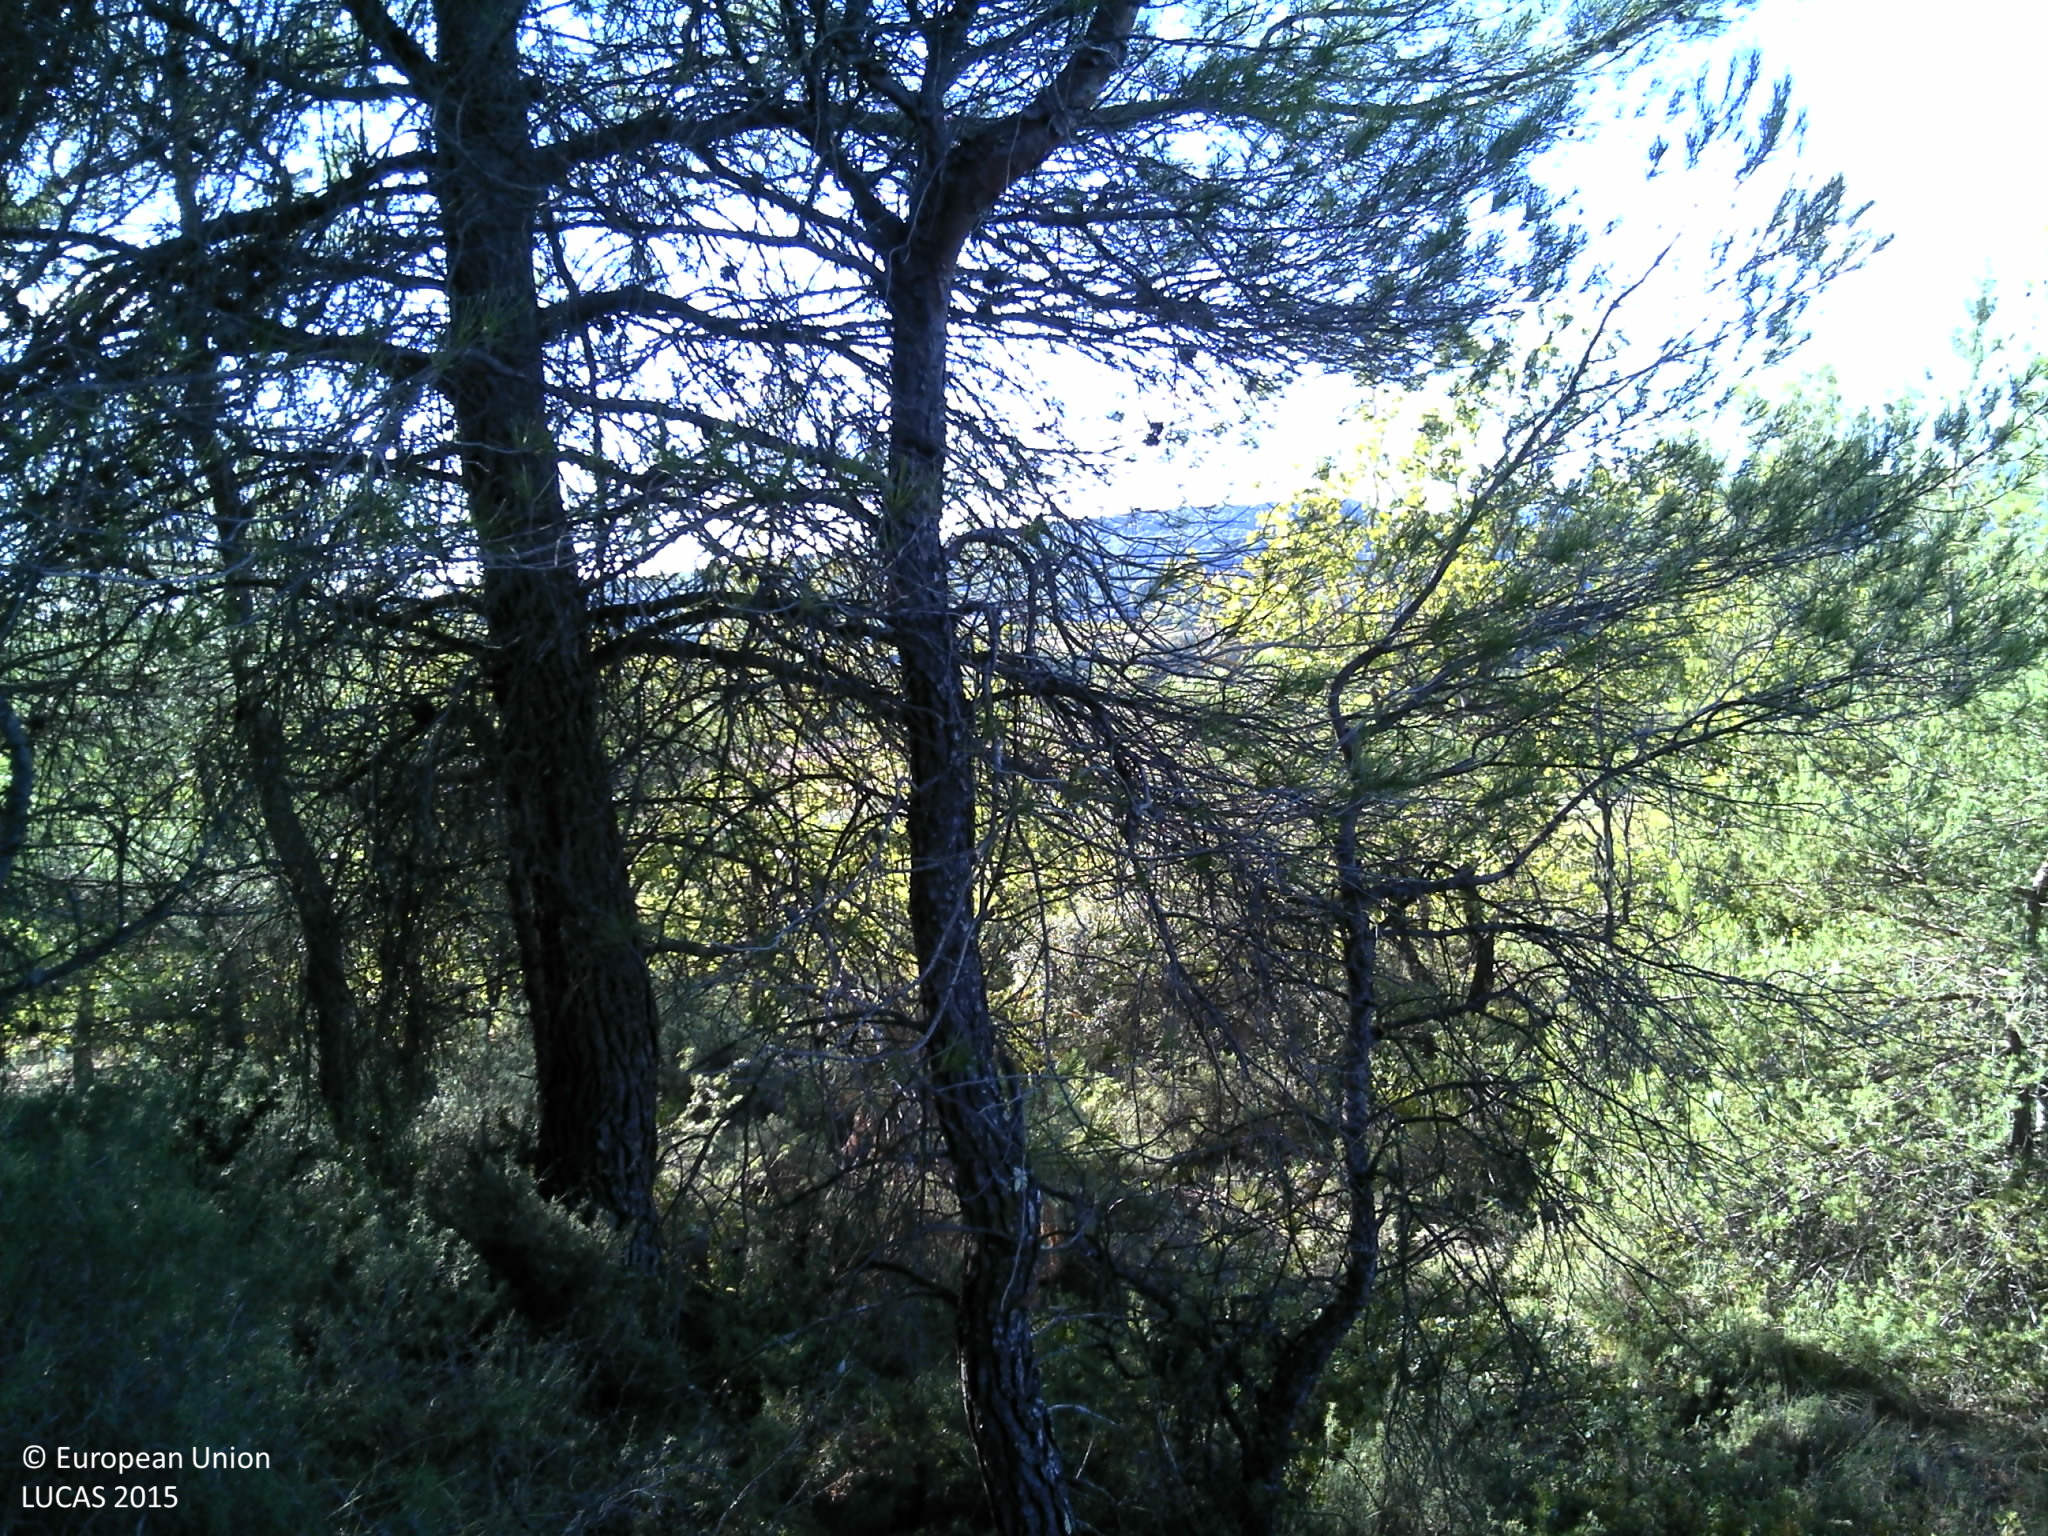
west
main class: Woodland
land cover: Pine dominated mixed woodland
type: coniferous forest of the mediterranean region
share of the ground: 50 - 75 %
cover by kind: coniferous forest trees 50 %, broadleaved forest trees 25 %, shrubs 20 %, herbaceous plants 5 %
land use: Forestry
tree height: > 5 m
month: September
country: FR
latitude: 43.8801
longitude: 5.2420
